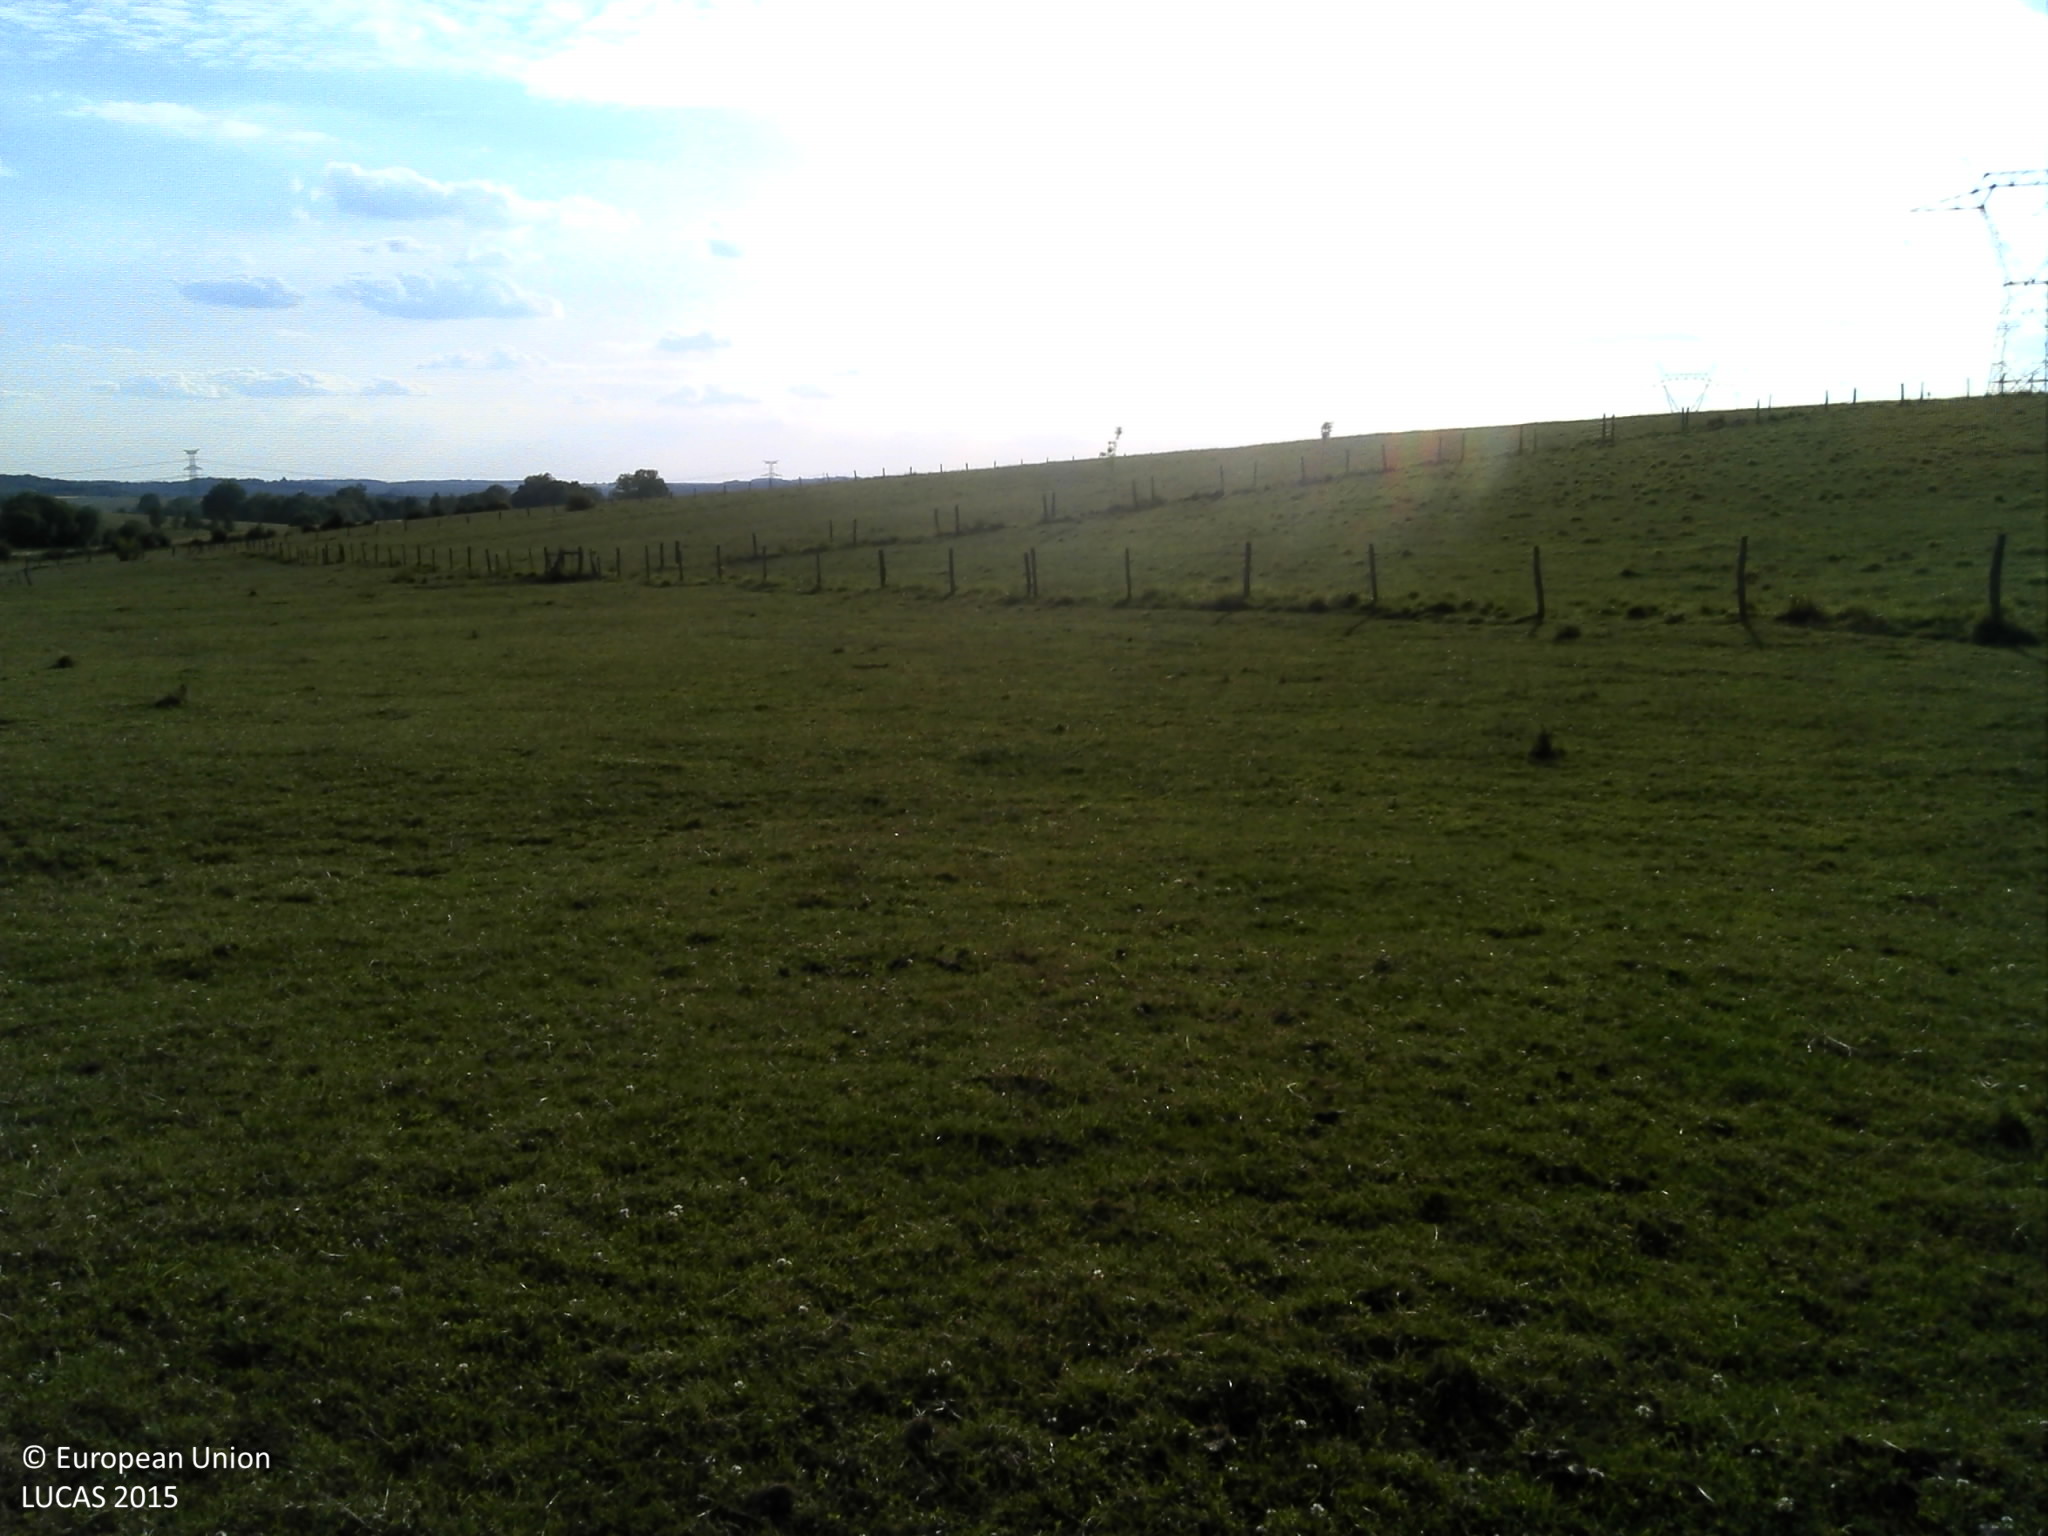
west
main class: Grassland
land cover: Grassland without tree/shrub cover
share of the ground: > 75 %
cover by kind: herbaceous plants 100 %
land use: Agriculture (excluding fallow land and kitchen gardens)
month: June
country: FR
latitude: 49.1577
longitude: 6.4759
